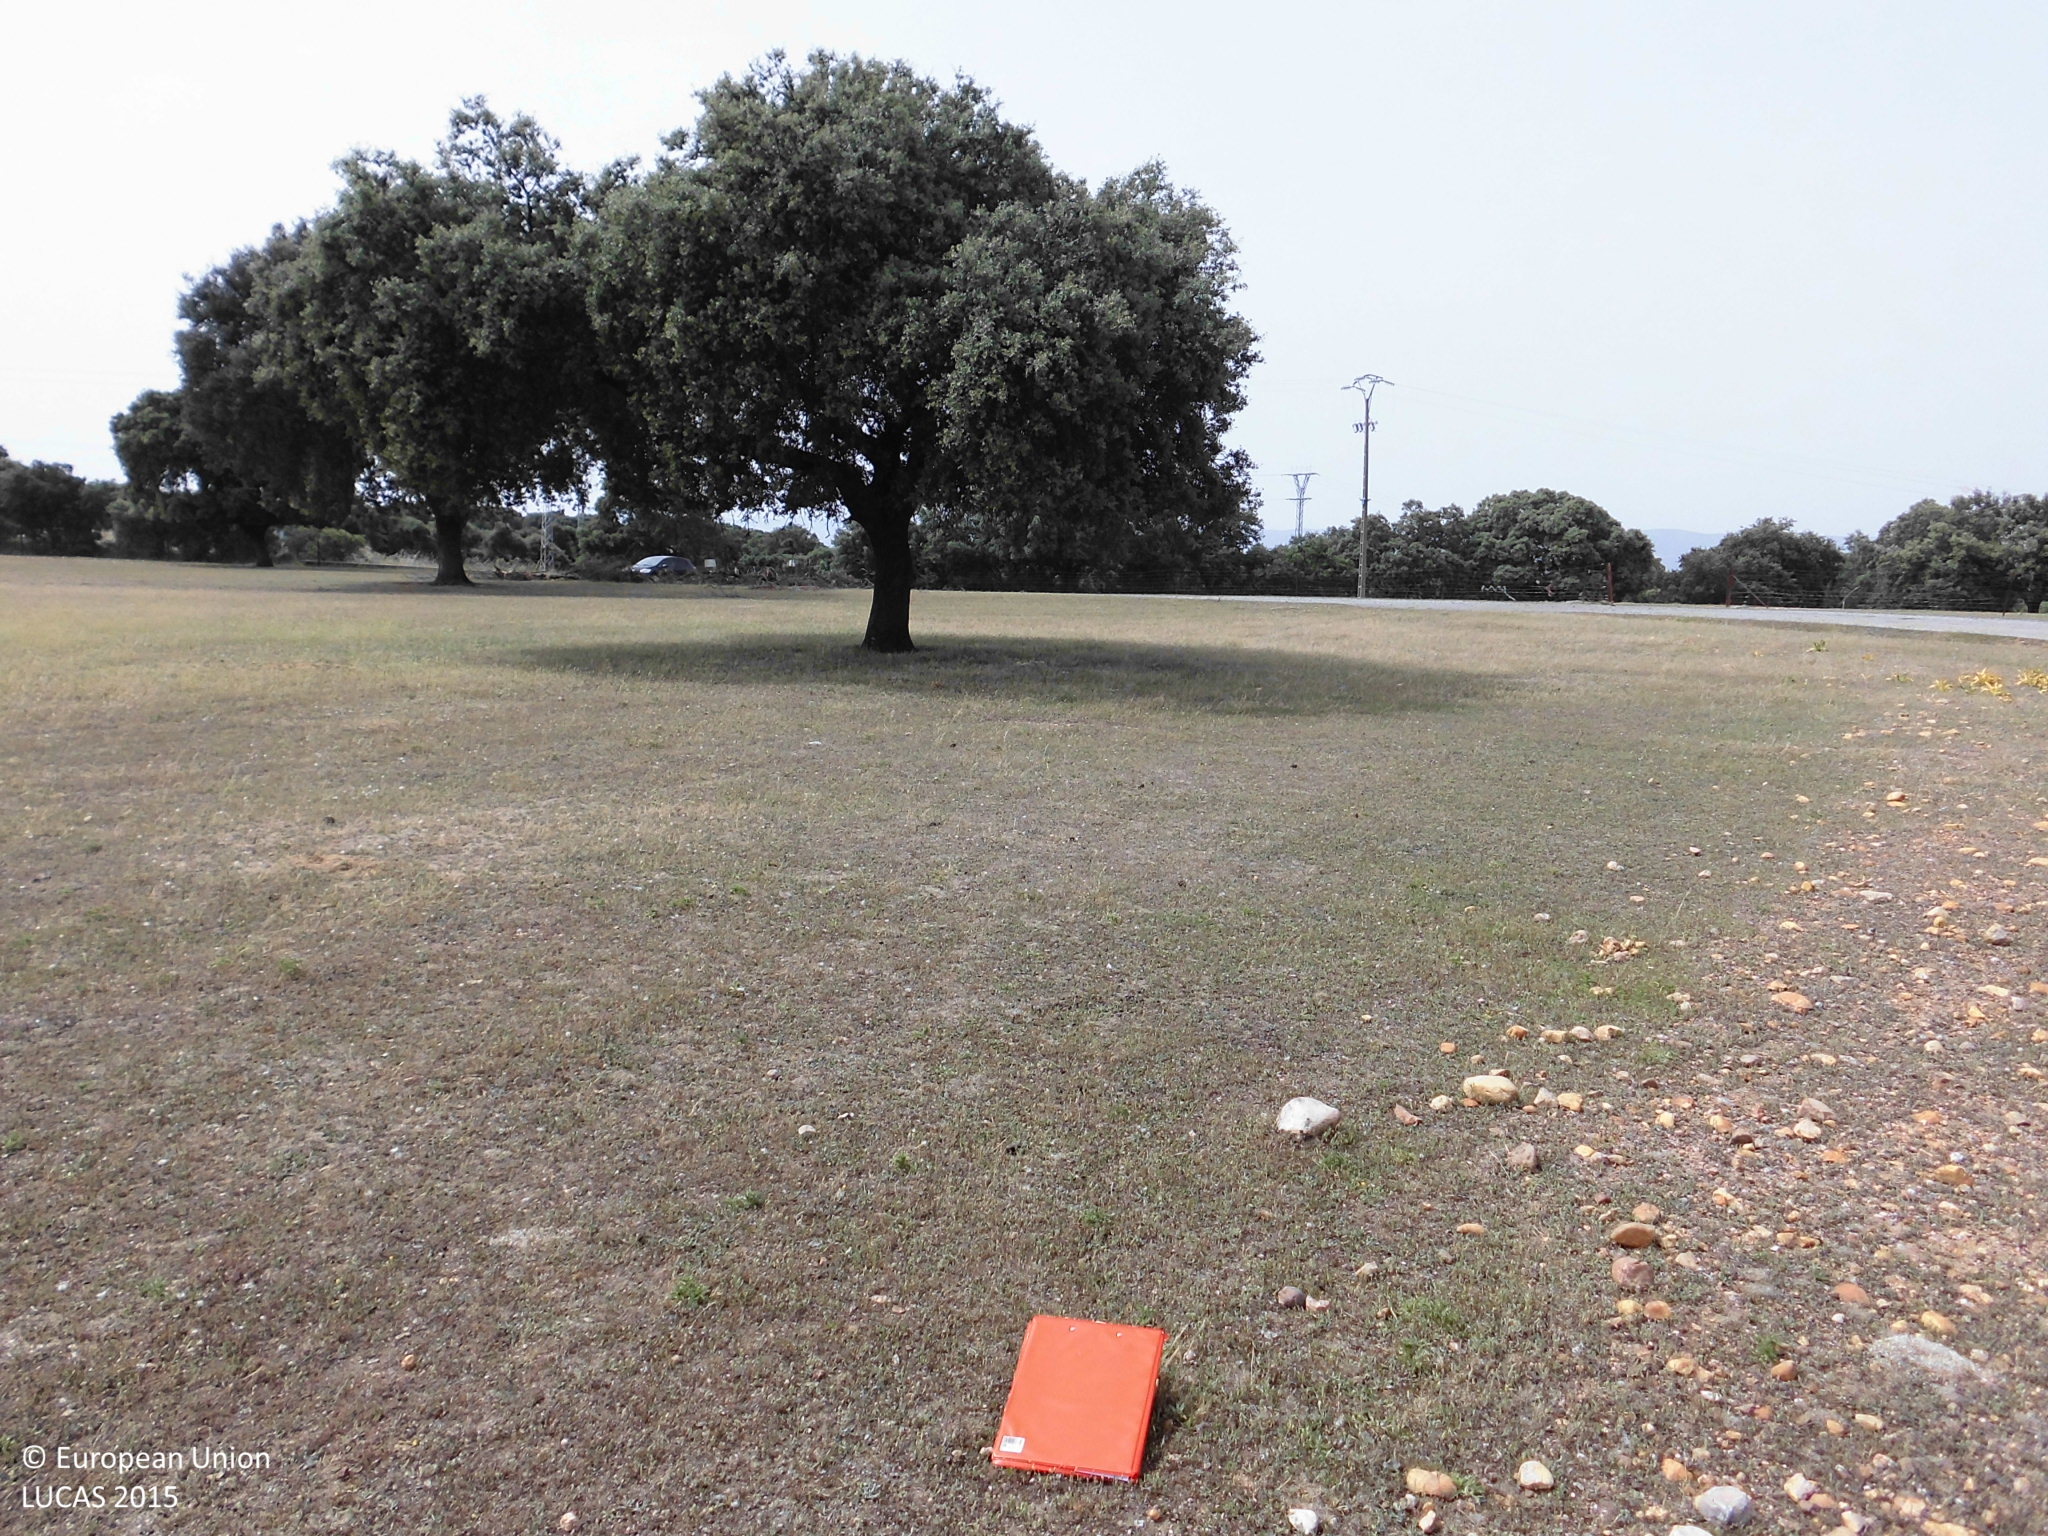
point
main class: Grassland
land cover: Grassland with sparse tree/shrub cover
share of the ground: > 75 %
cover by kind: herbaceous plants 65 %, consolidated bare surface 30 %, broadleaved forest trees 5 %
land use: Agriculture (excluding fallow land and kitchen gardens)
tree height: > 5 m
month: May
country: ES
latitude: 39.6928
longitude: -6.1480
